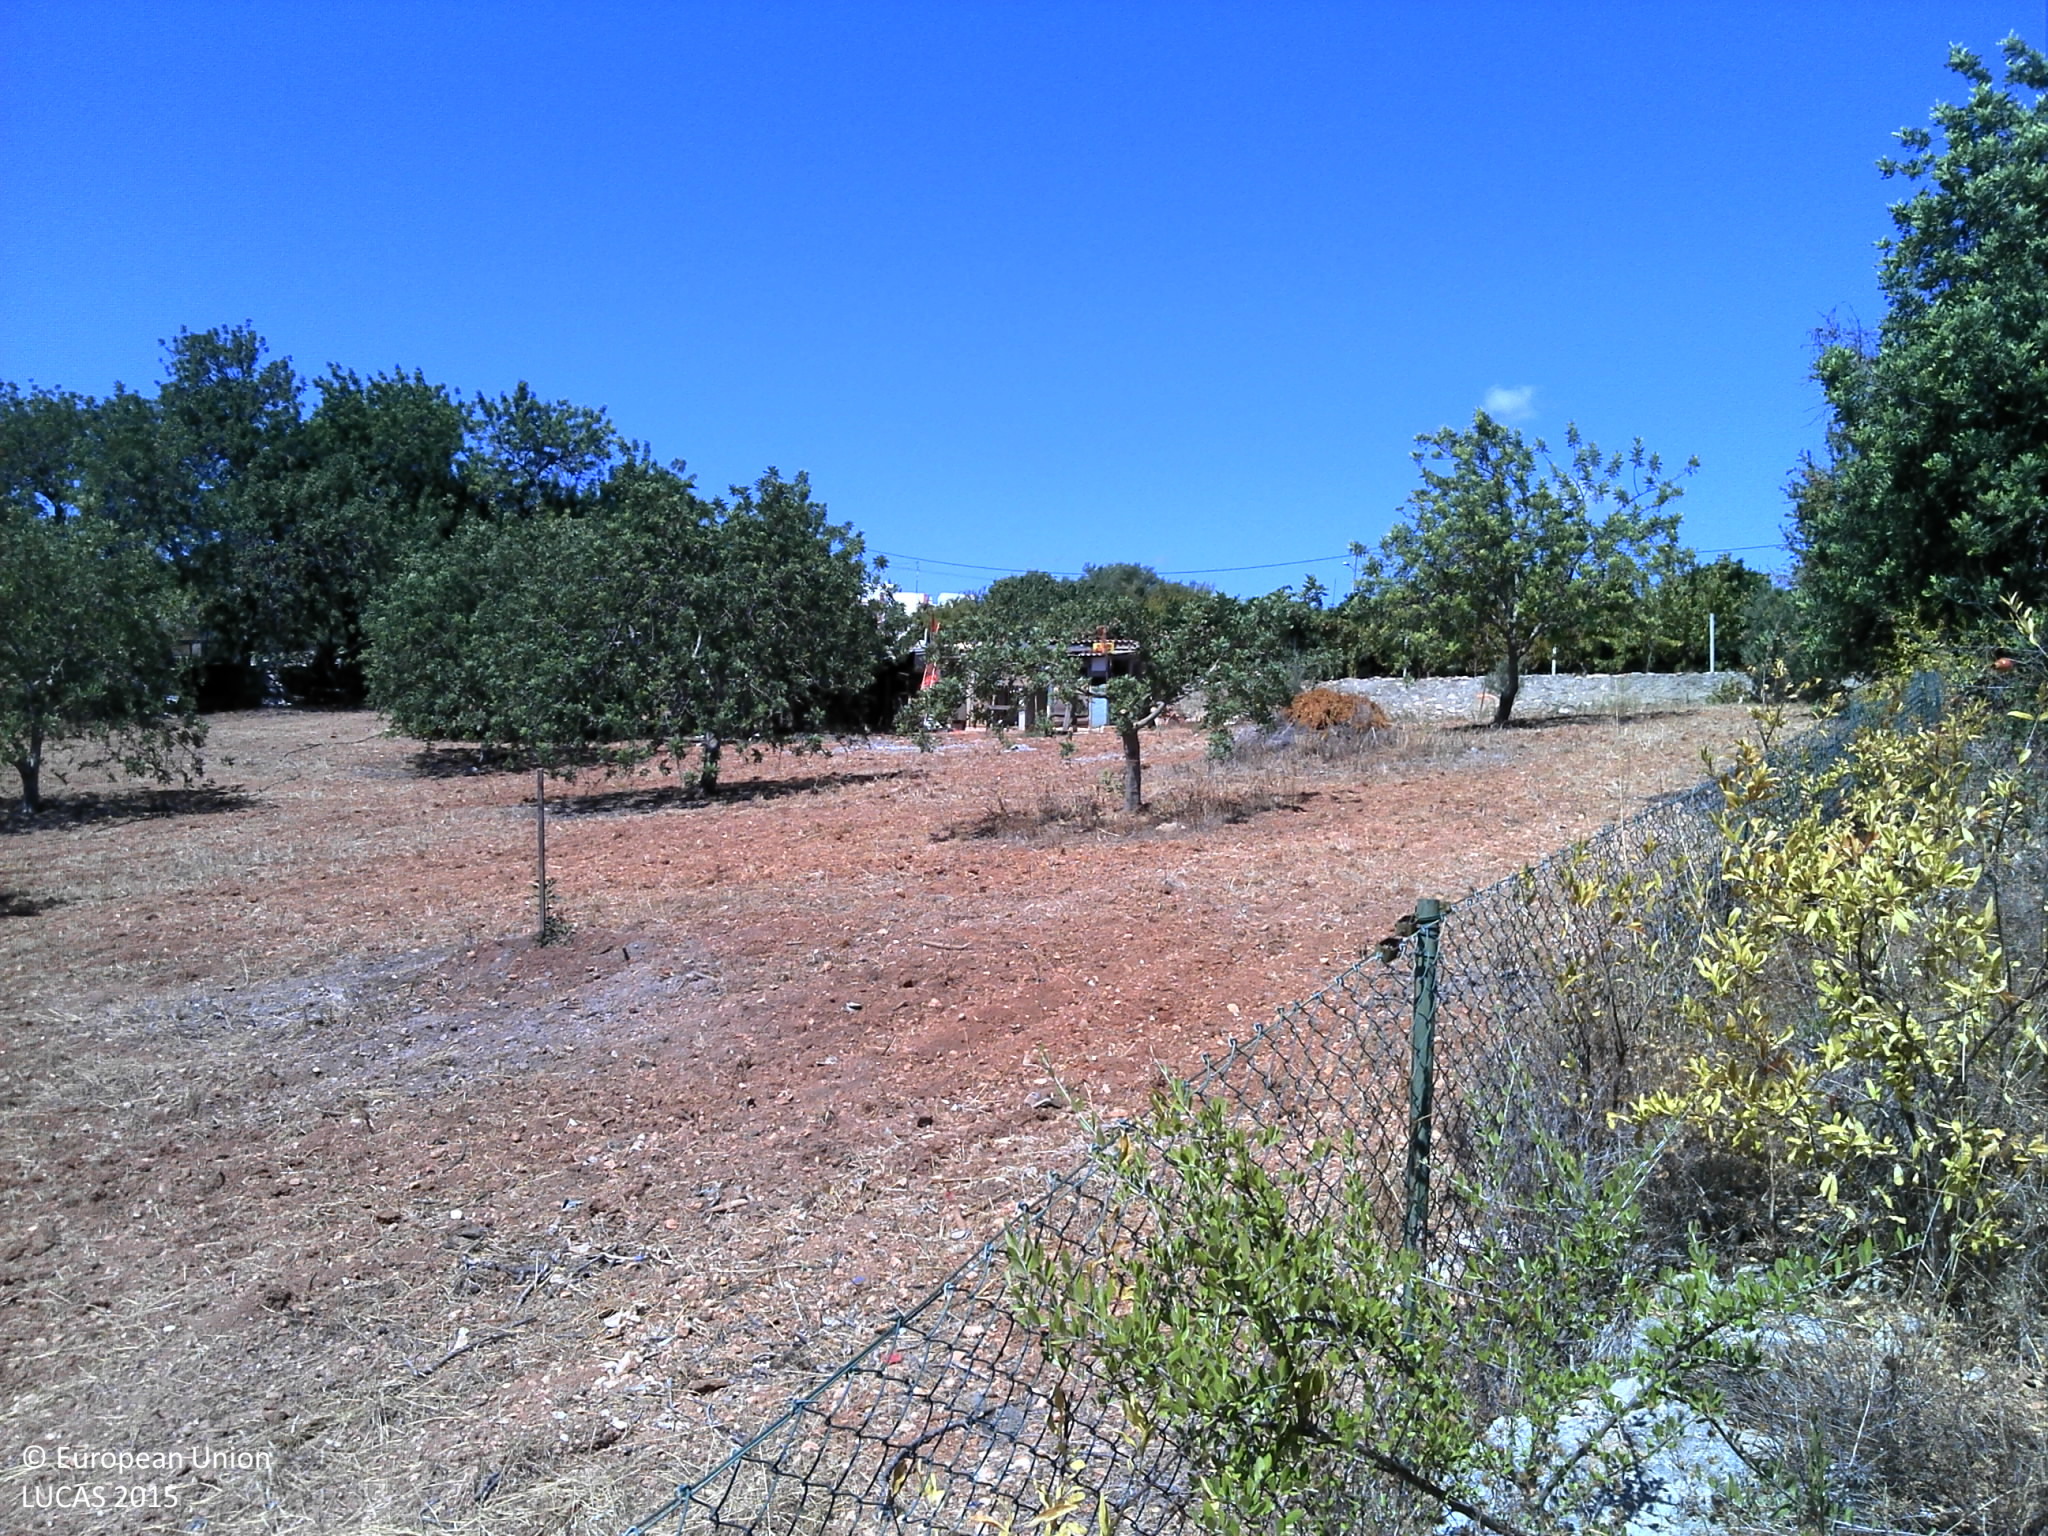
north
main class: Cropland
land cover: Permanent industrial crops
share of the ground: 25 - 50 %
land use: Agriculture (excluding fallow land and kitchen gardens)
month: September
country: PT
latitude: 37.1201
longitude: -8.1241
